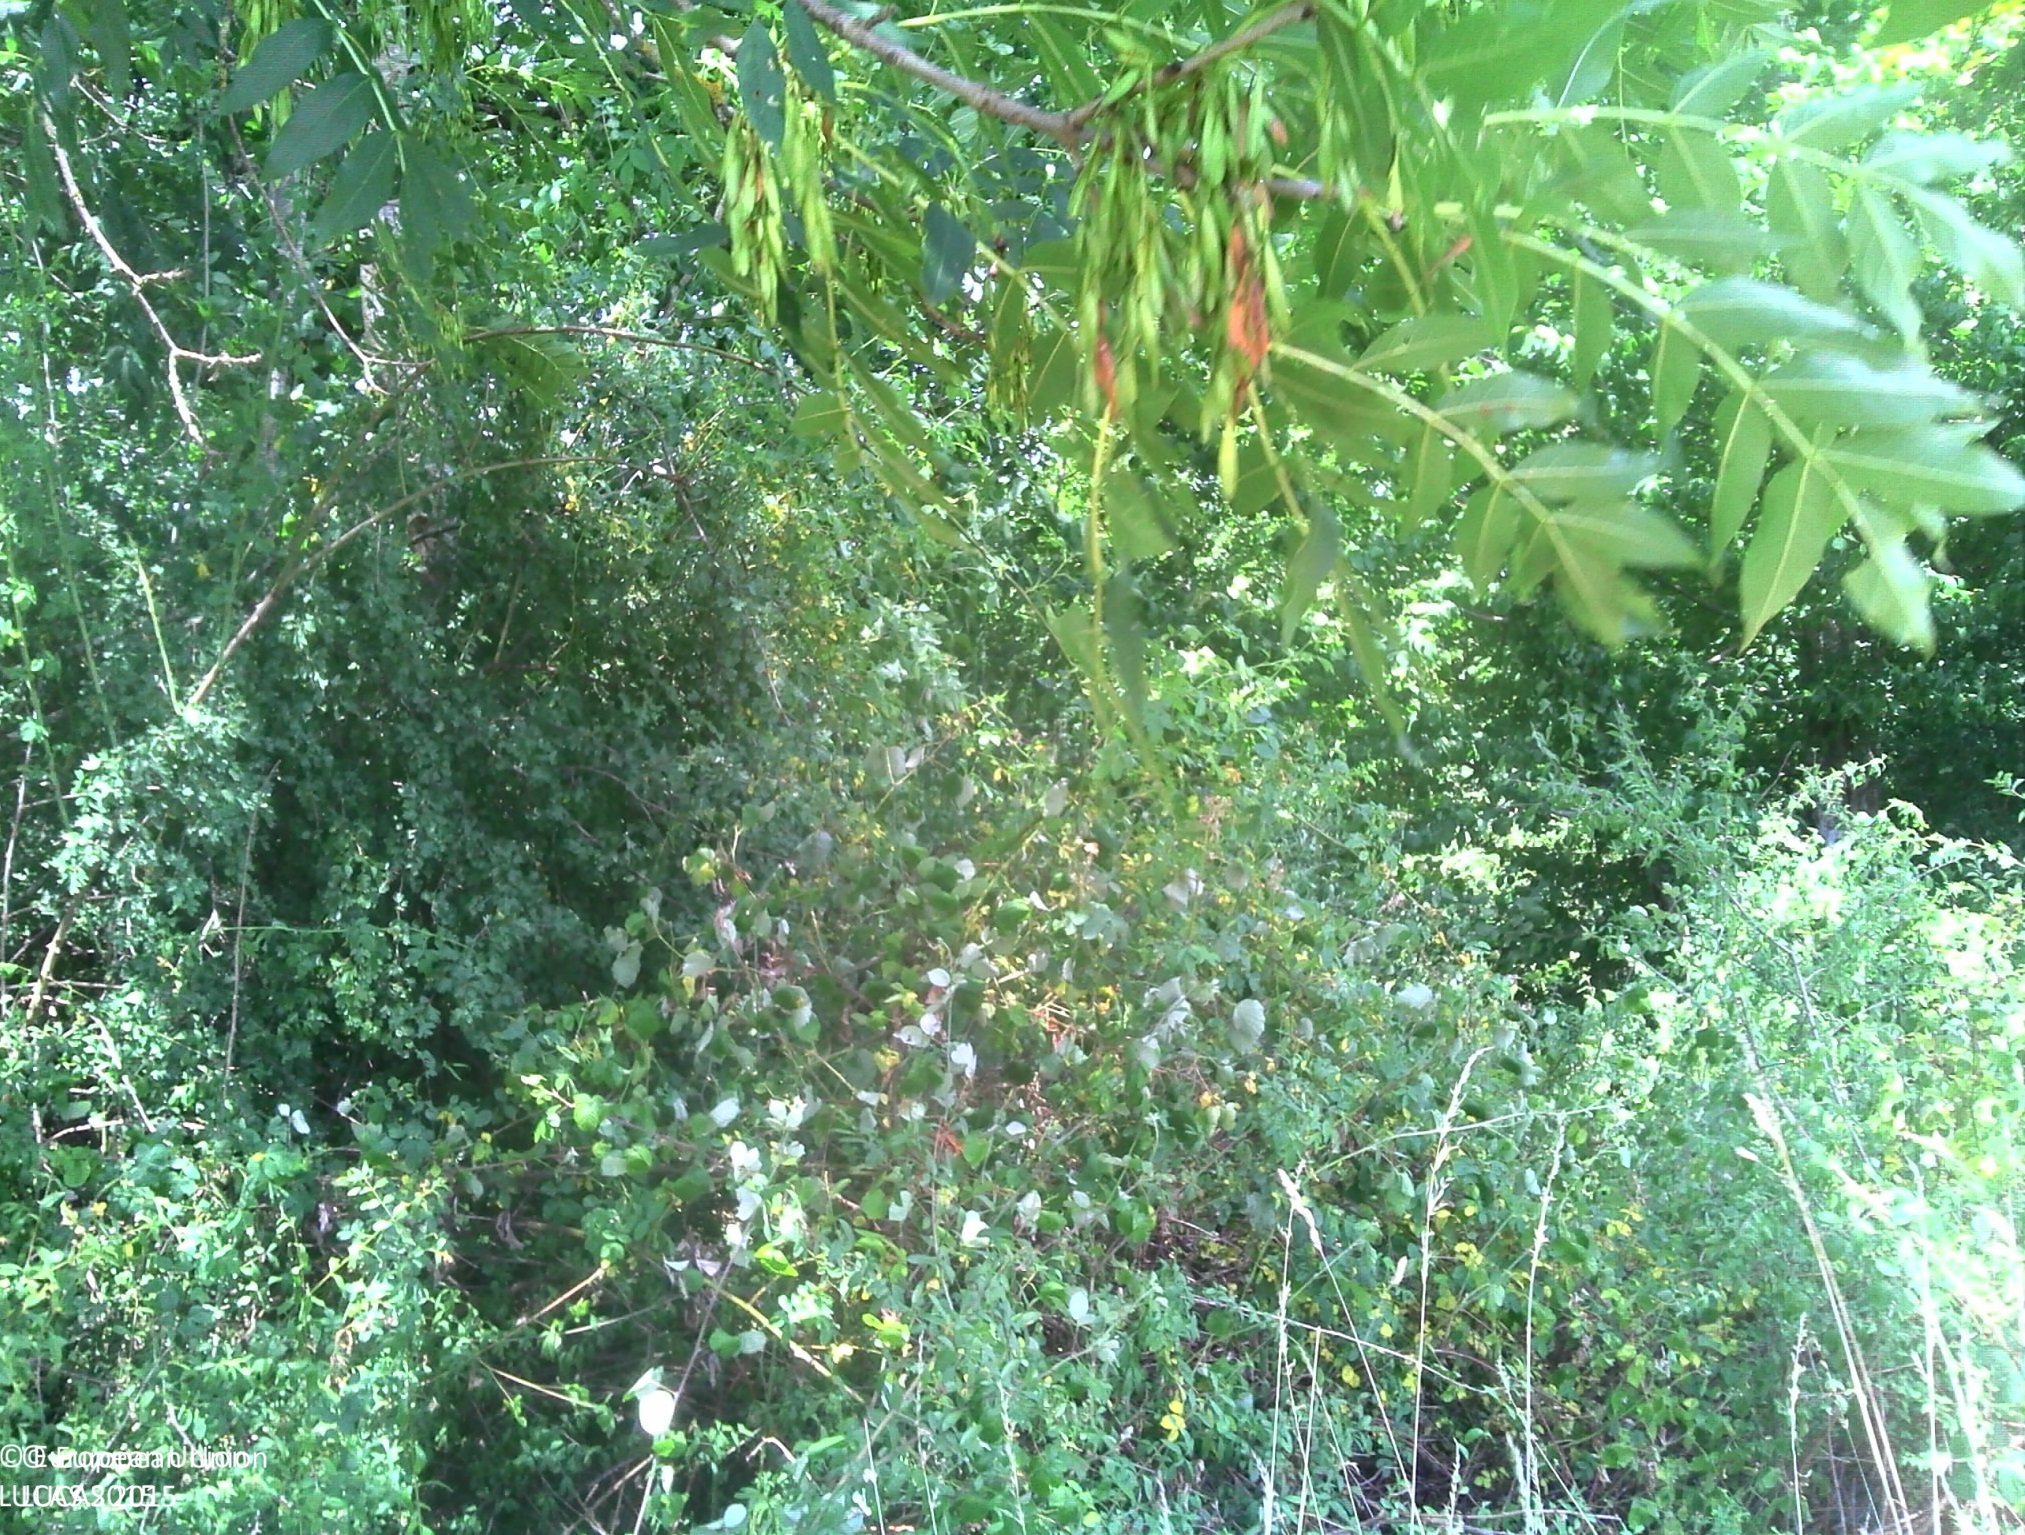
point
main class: Woodland
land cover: Broadleaved woodland
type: mesophytic deciduous forest
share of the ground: > 75 %
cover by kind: broadleaved forest trees 60 %, shrubs 20 %, herbaceous plants 20 %
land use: Forestry
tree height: > 5 m
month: July
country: FR
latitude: 45.7983
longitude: 5.3336
